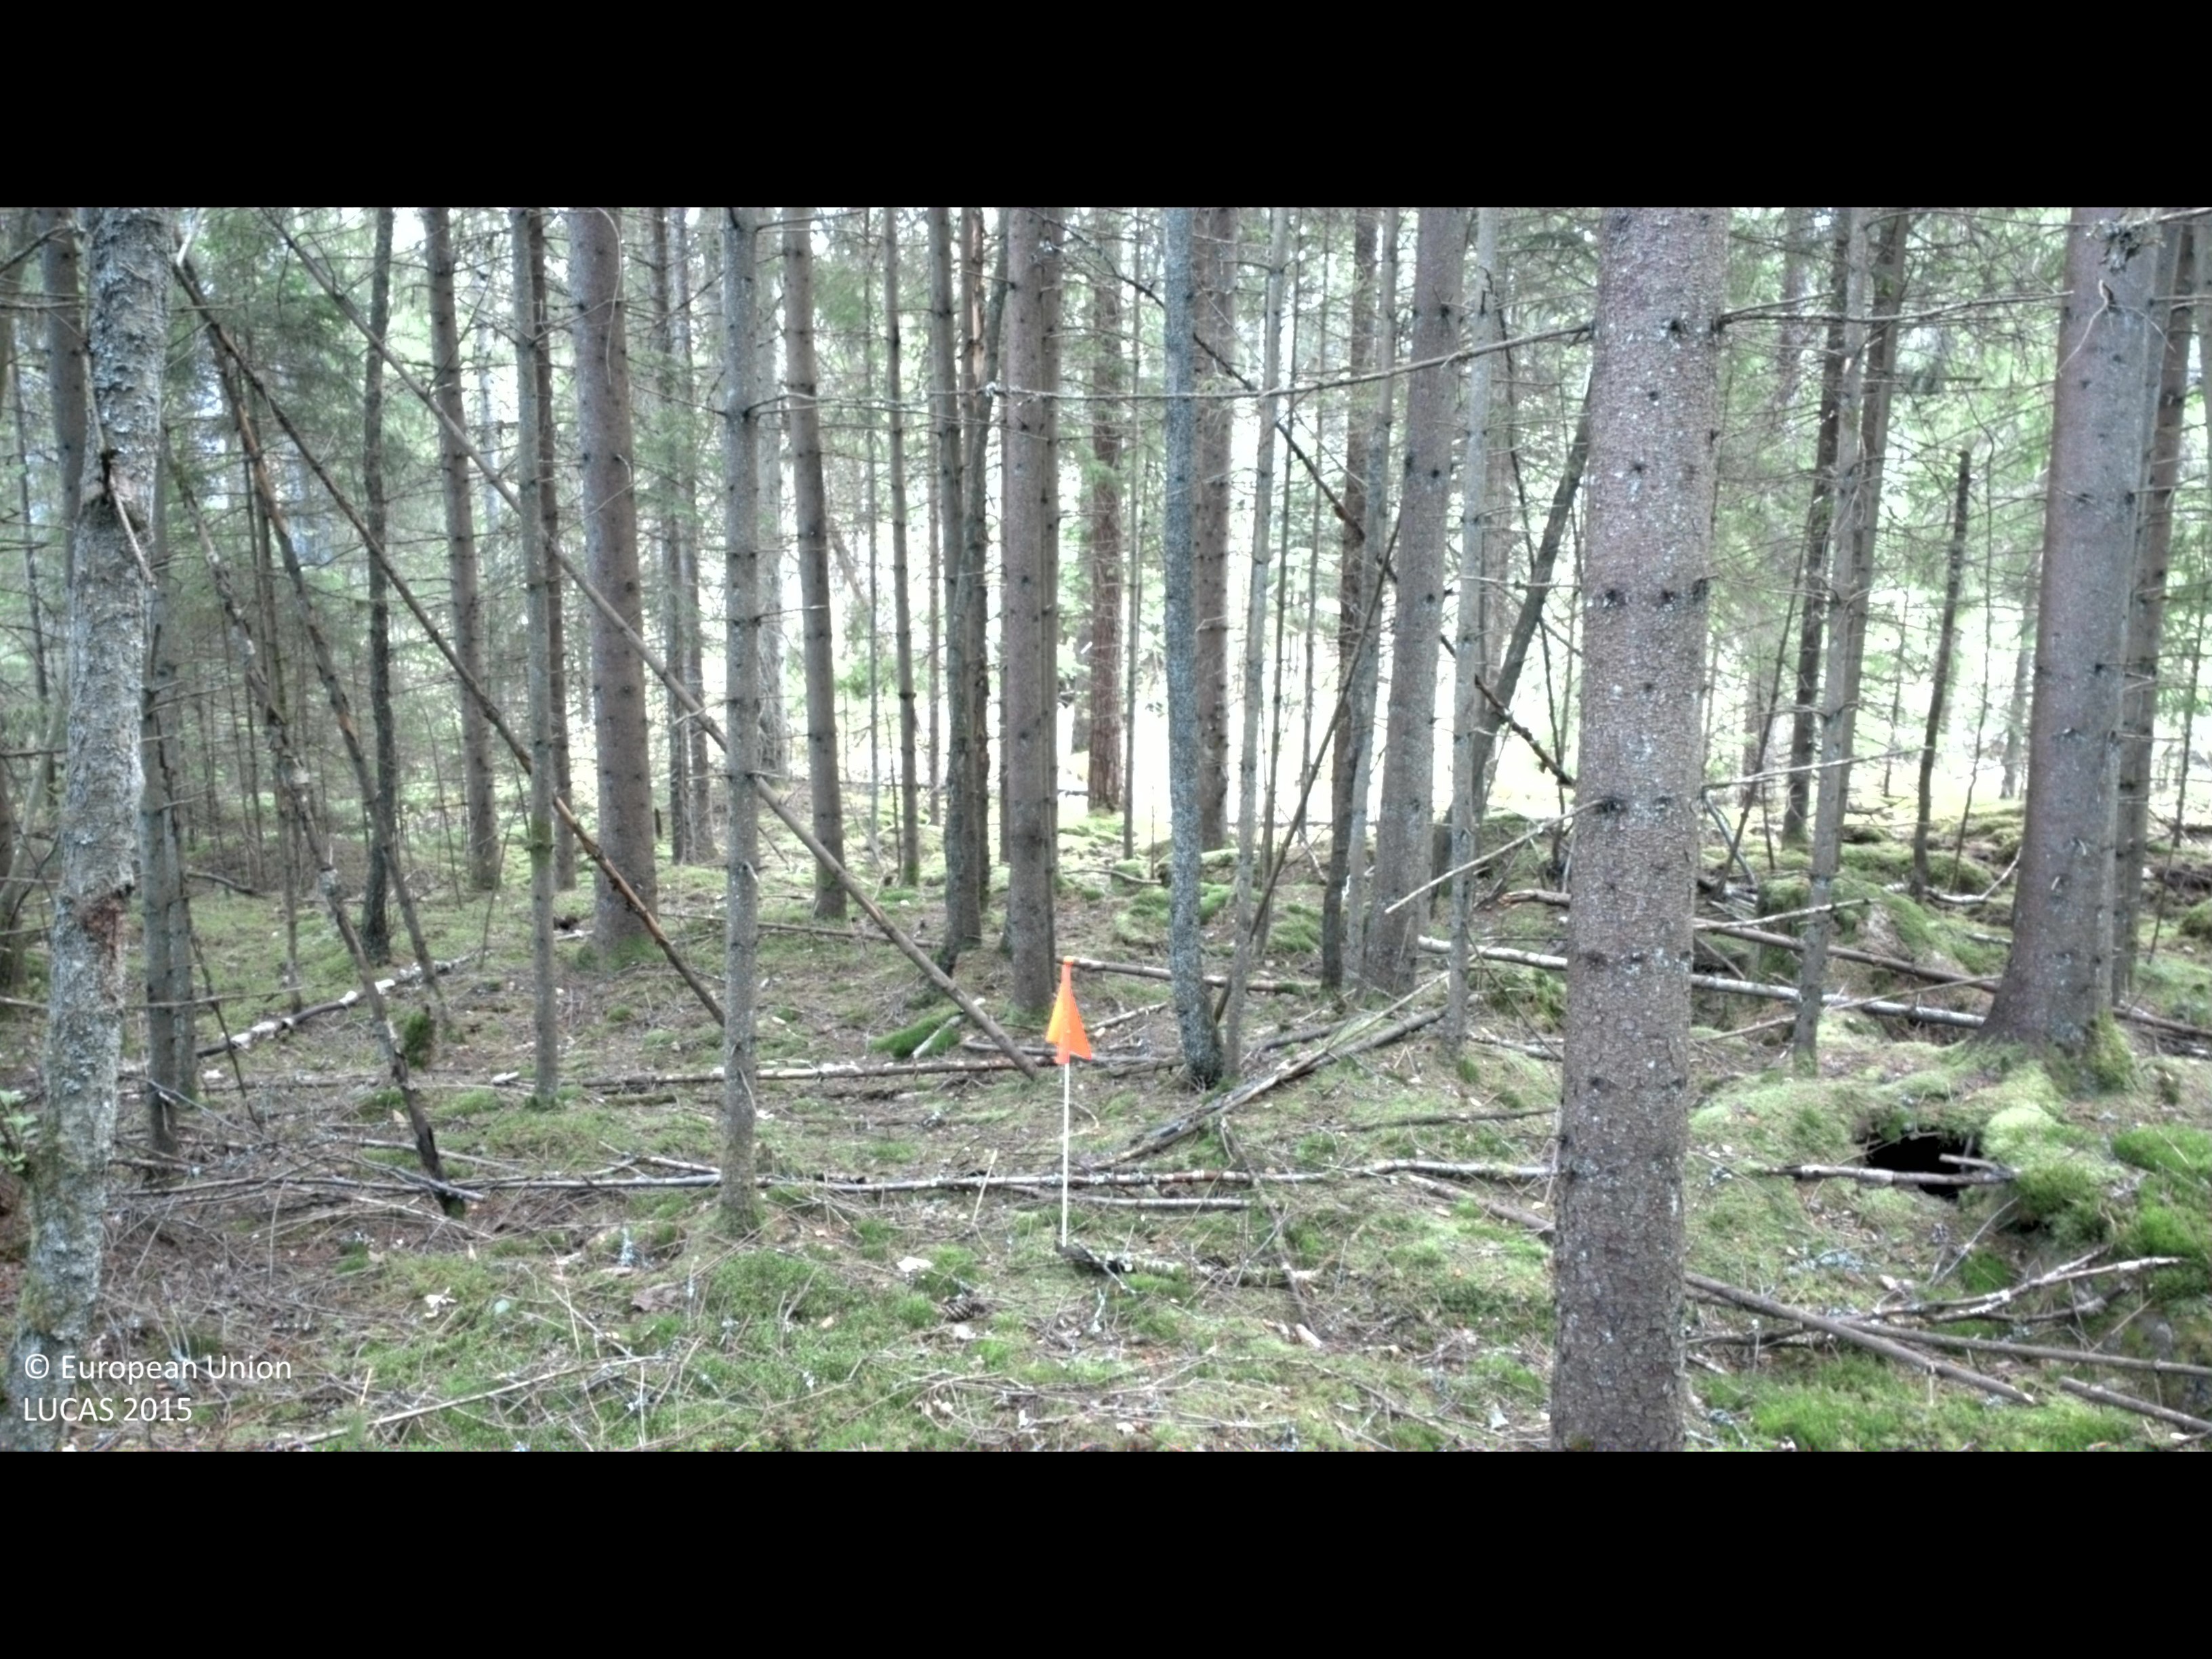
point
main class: Woodland
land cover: Spruce dominated coniferous woodland
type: boreal forest
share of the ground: > 75 %
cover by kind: coniferous forest trees 80 %, shrubs 10 %, herbaceous plants 5 %, lichens and mosses 5 %
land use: Forestry
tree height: > 5 m
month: July
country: SE
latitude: 56.5270
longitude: 13.8174
